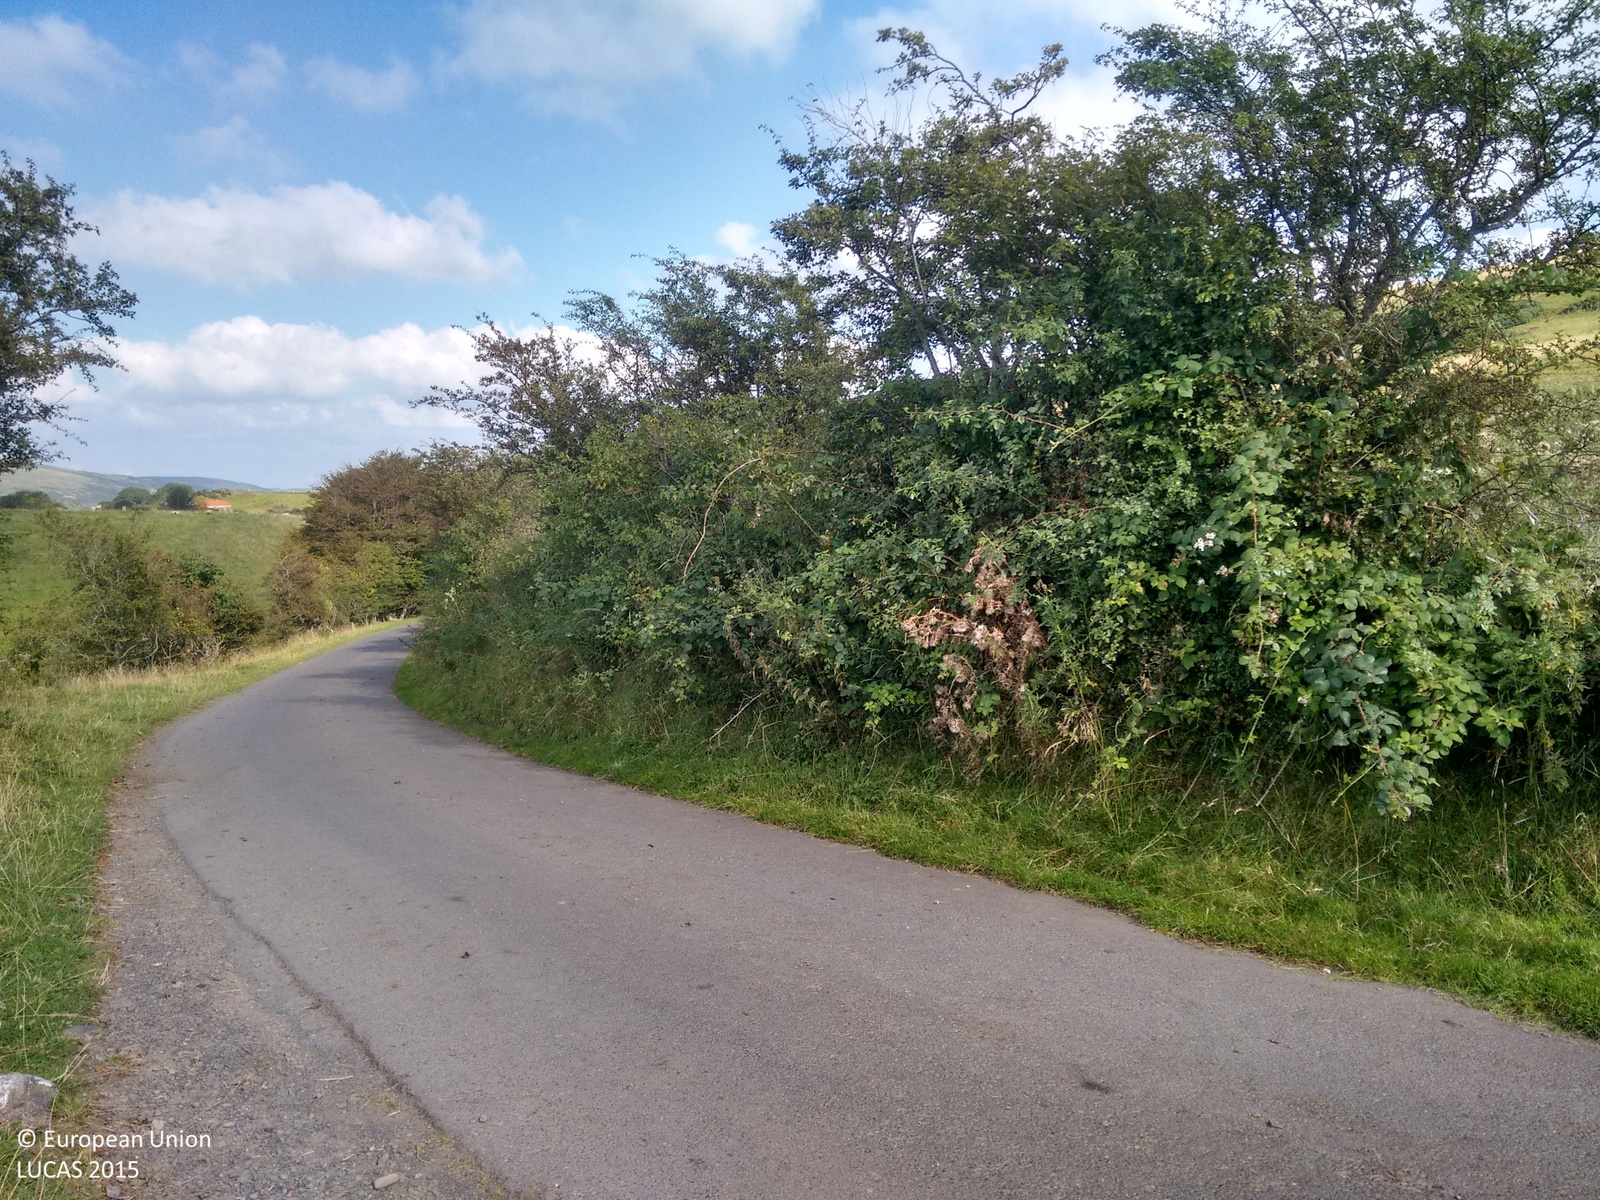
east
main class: Grassland
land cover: Grassland without tree/shrub cover
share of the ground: > 75 %
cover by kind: herbaceous plants 100 %
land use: Agriculture (excluding fallow land and kitchen gardens)
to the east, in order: Grassland without tree/shrub cover; Rivers and streams; Grass margins; Single bushes/trees; Fences; Grassland without tree/shrub cover; Fences; Grassland without tree/shrub cover
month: September
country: GB
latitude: 55.1239
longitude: -4.9303
